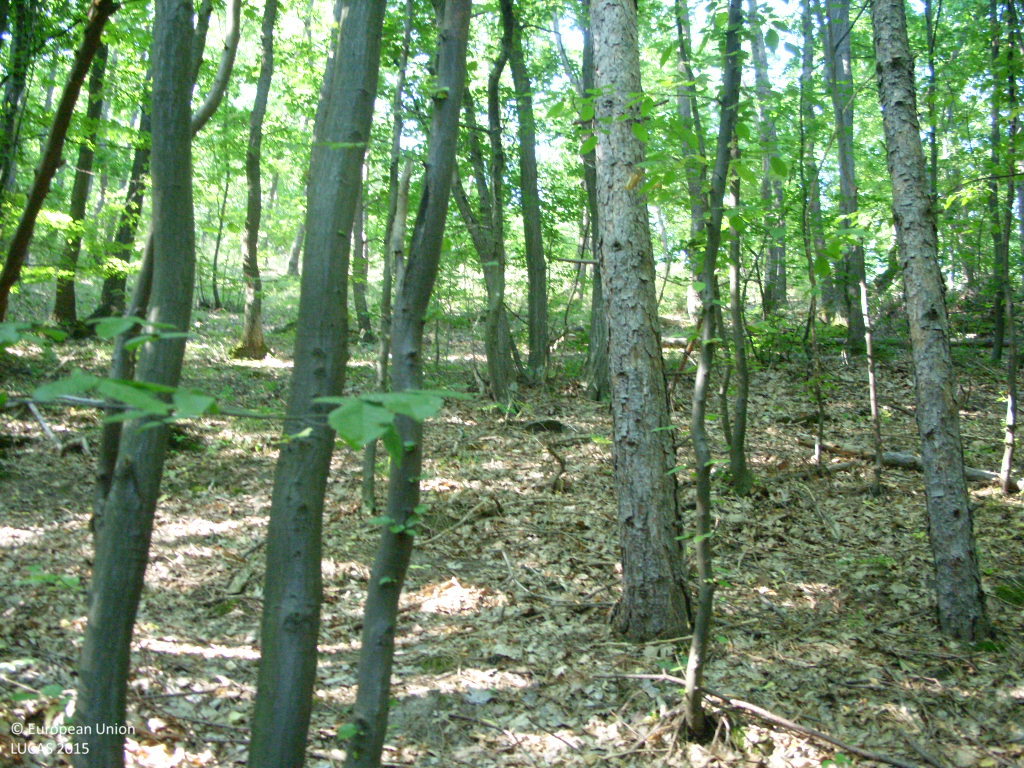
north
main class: Woodland
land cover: Broadleaved woodland
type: mesophytic deciduous forest
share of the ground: > 75 %
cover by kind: broadleaved forest trees 100 %
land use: Forestry
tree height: > 5 m
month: July
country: BG
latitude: 42.2939
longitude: 23.9020
